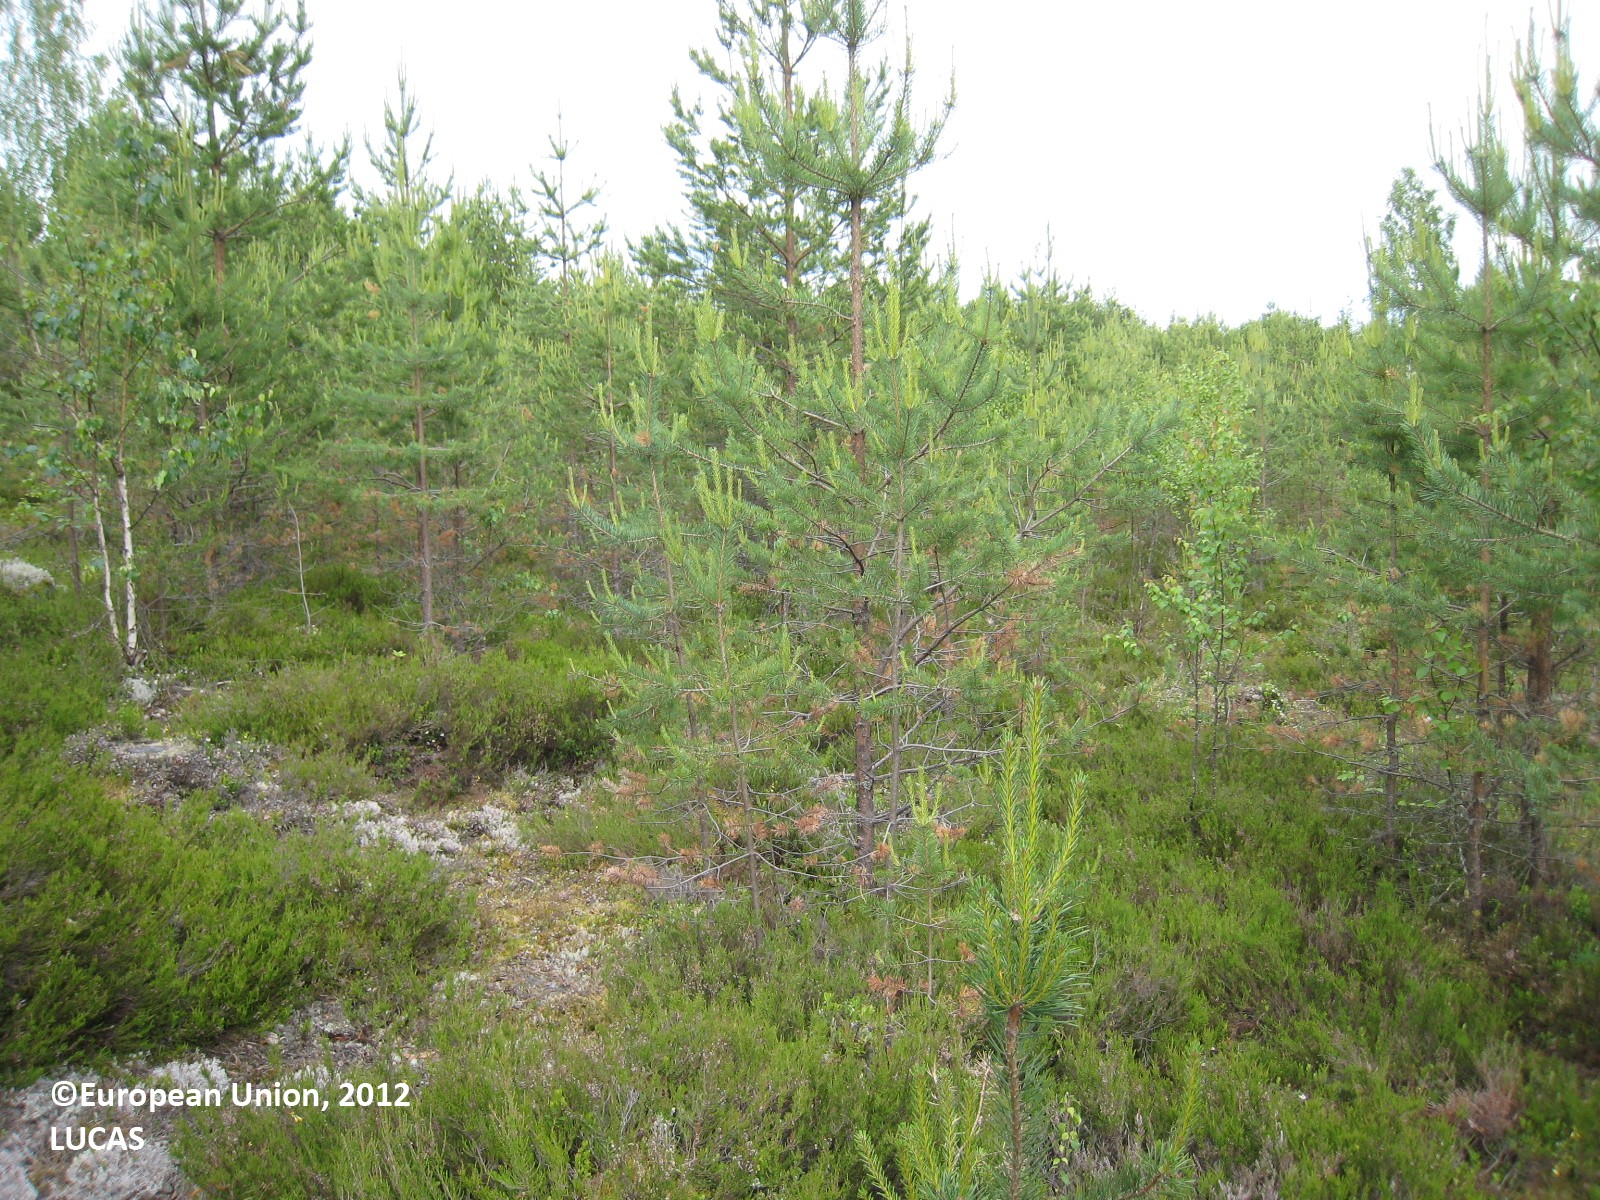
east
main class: Woodland
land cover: Pine dominated coniferous woodland
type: boreal forest
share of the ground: 50 - 75 %
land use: Forestry
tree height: < 5 m
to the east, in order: Pine dominated coniferous woodland; Pine dominated mixed woodland
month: June
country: FI
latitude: 61.9863
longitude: 26.1848
